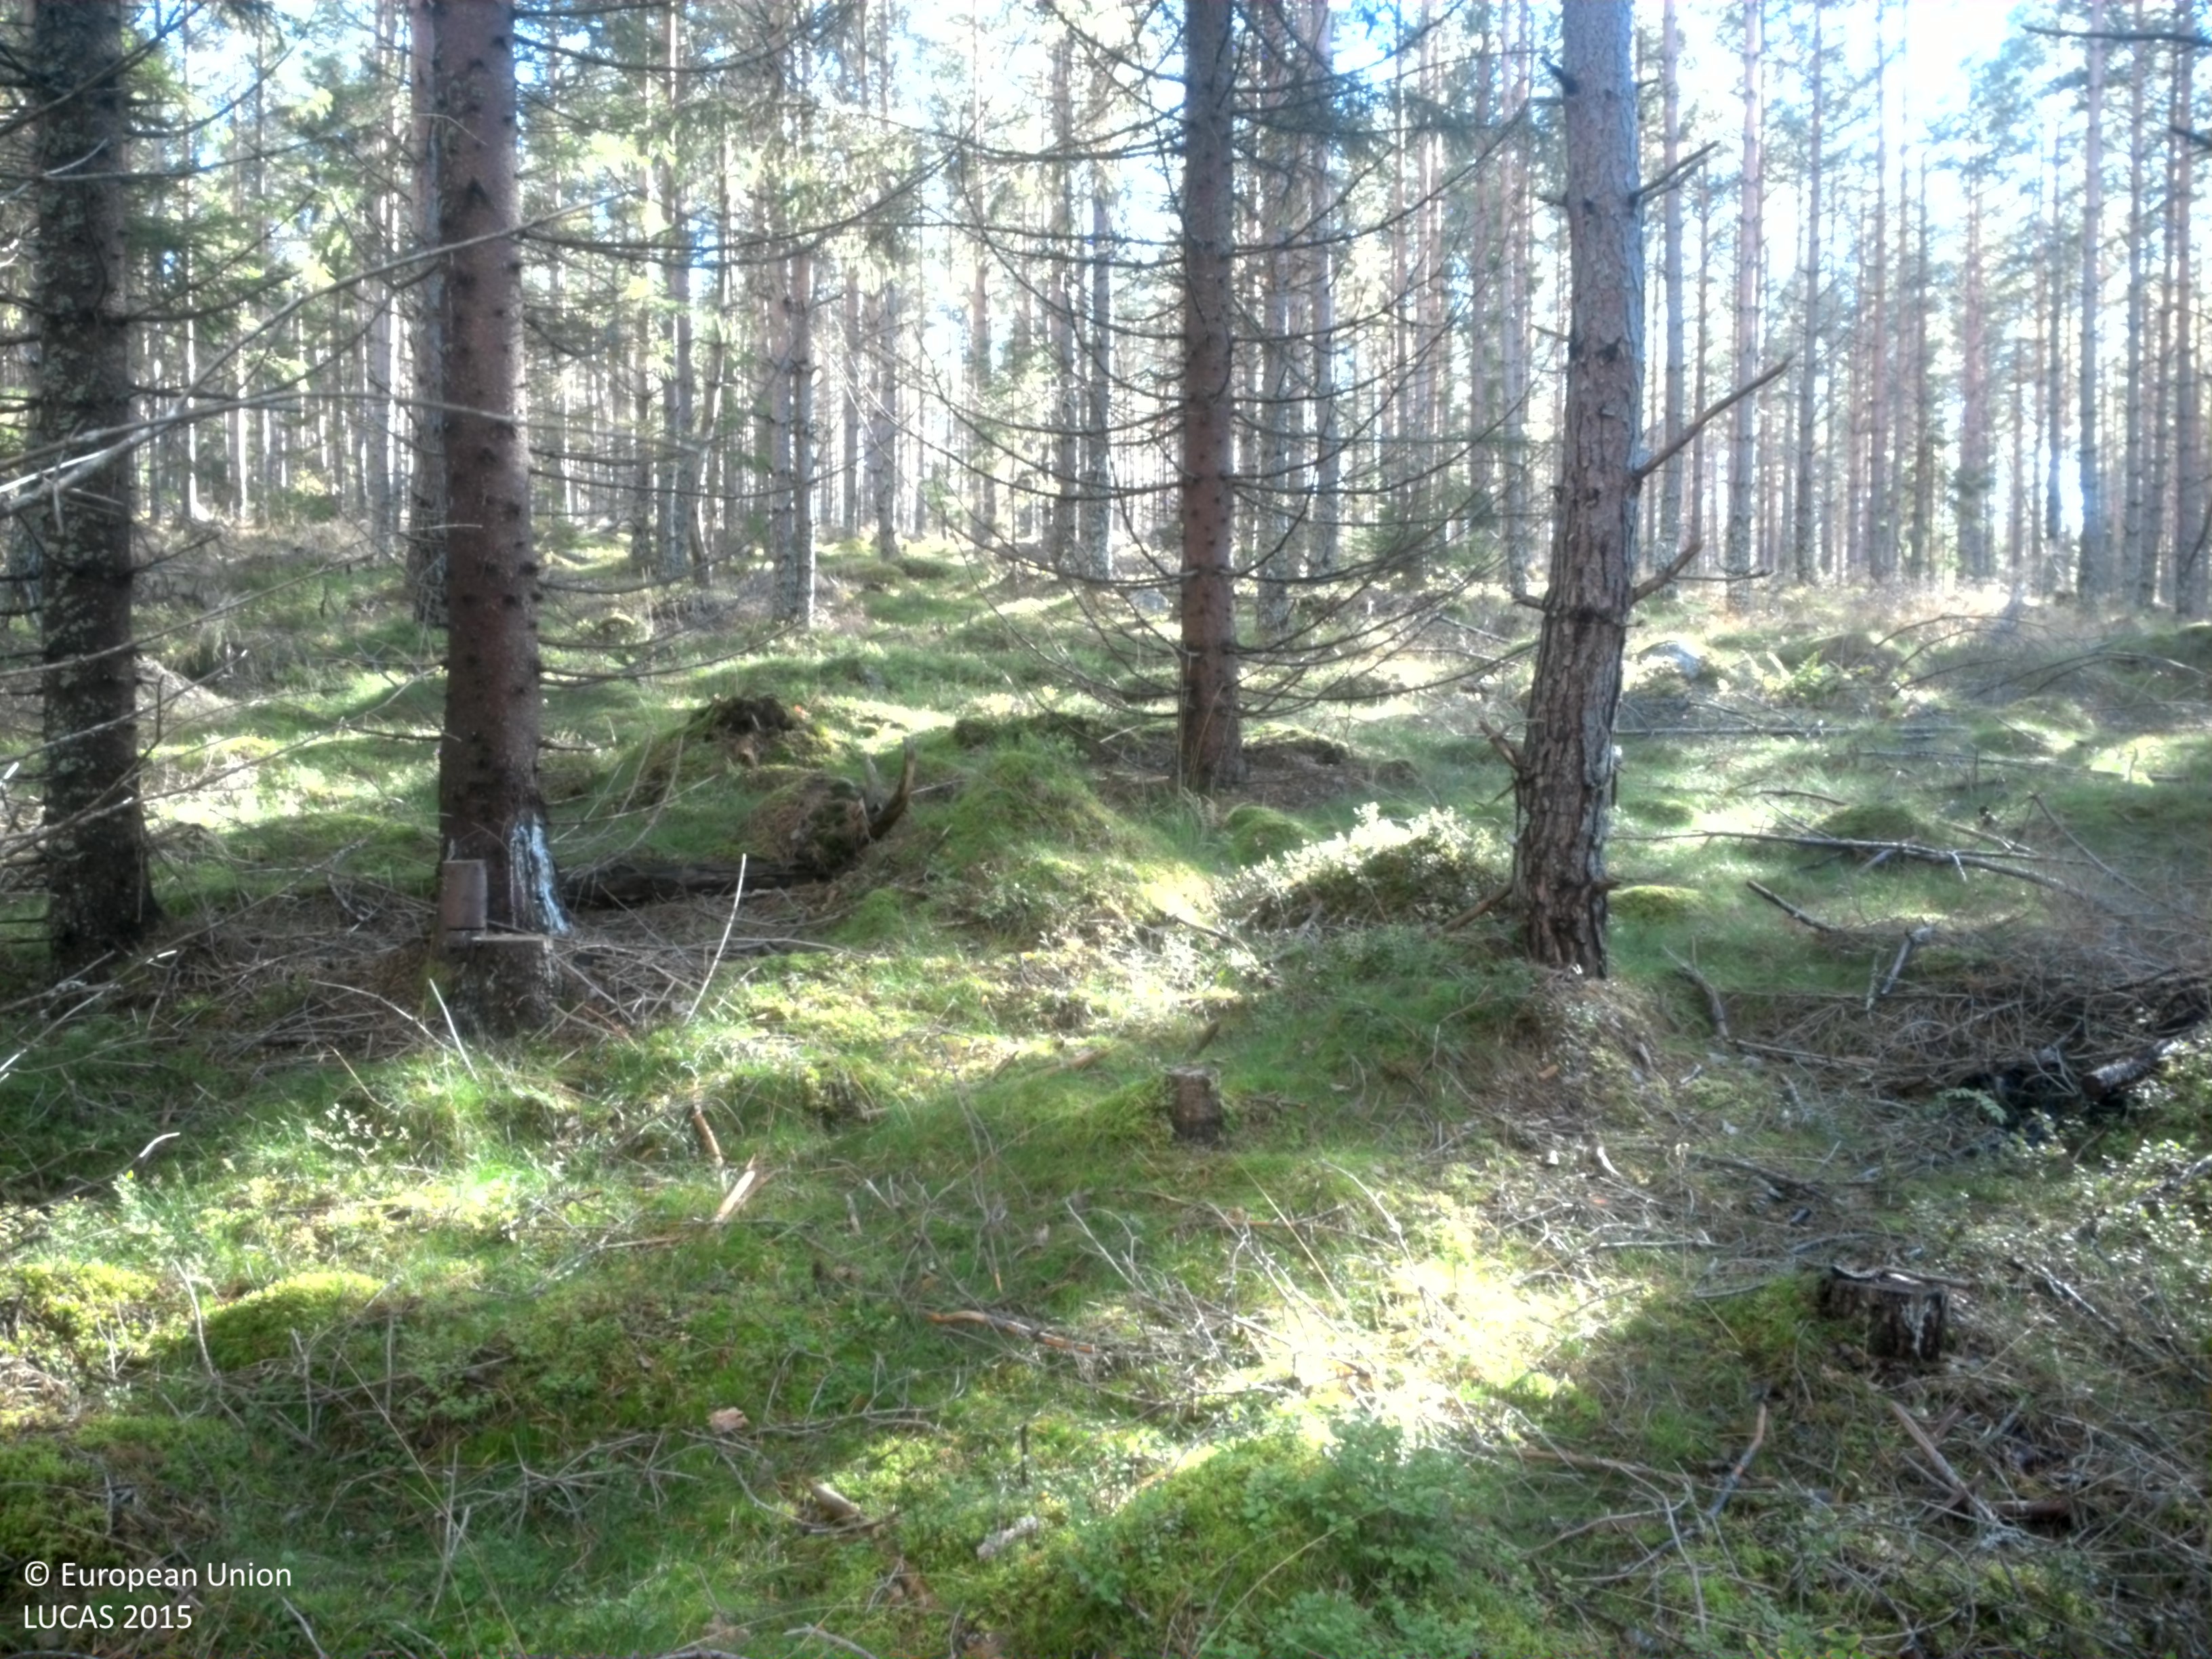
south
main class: Woodland
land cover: Other coniferous woodland
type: boreal forest
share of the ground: > 75 %
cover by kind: coniferous forest trees 75 %, shrubs 10 %, lichens and mosses 10 %, herbaceous plants 5 %
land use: Forestry
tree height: > 5 m
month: September
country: SE
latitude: 59.8925
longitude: 15.5123
